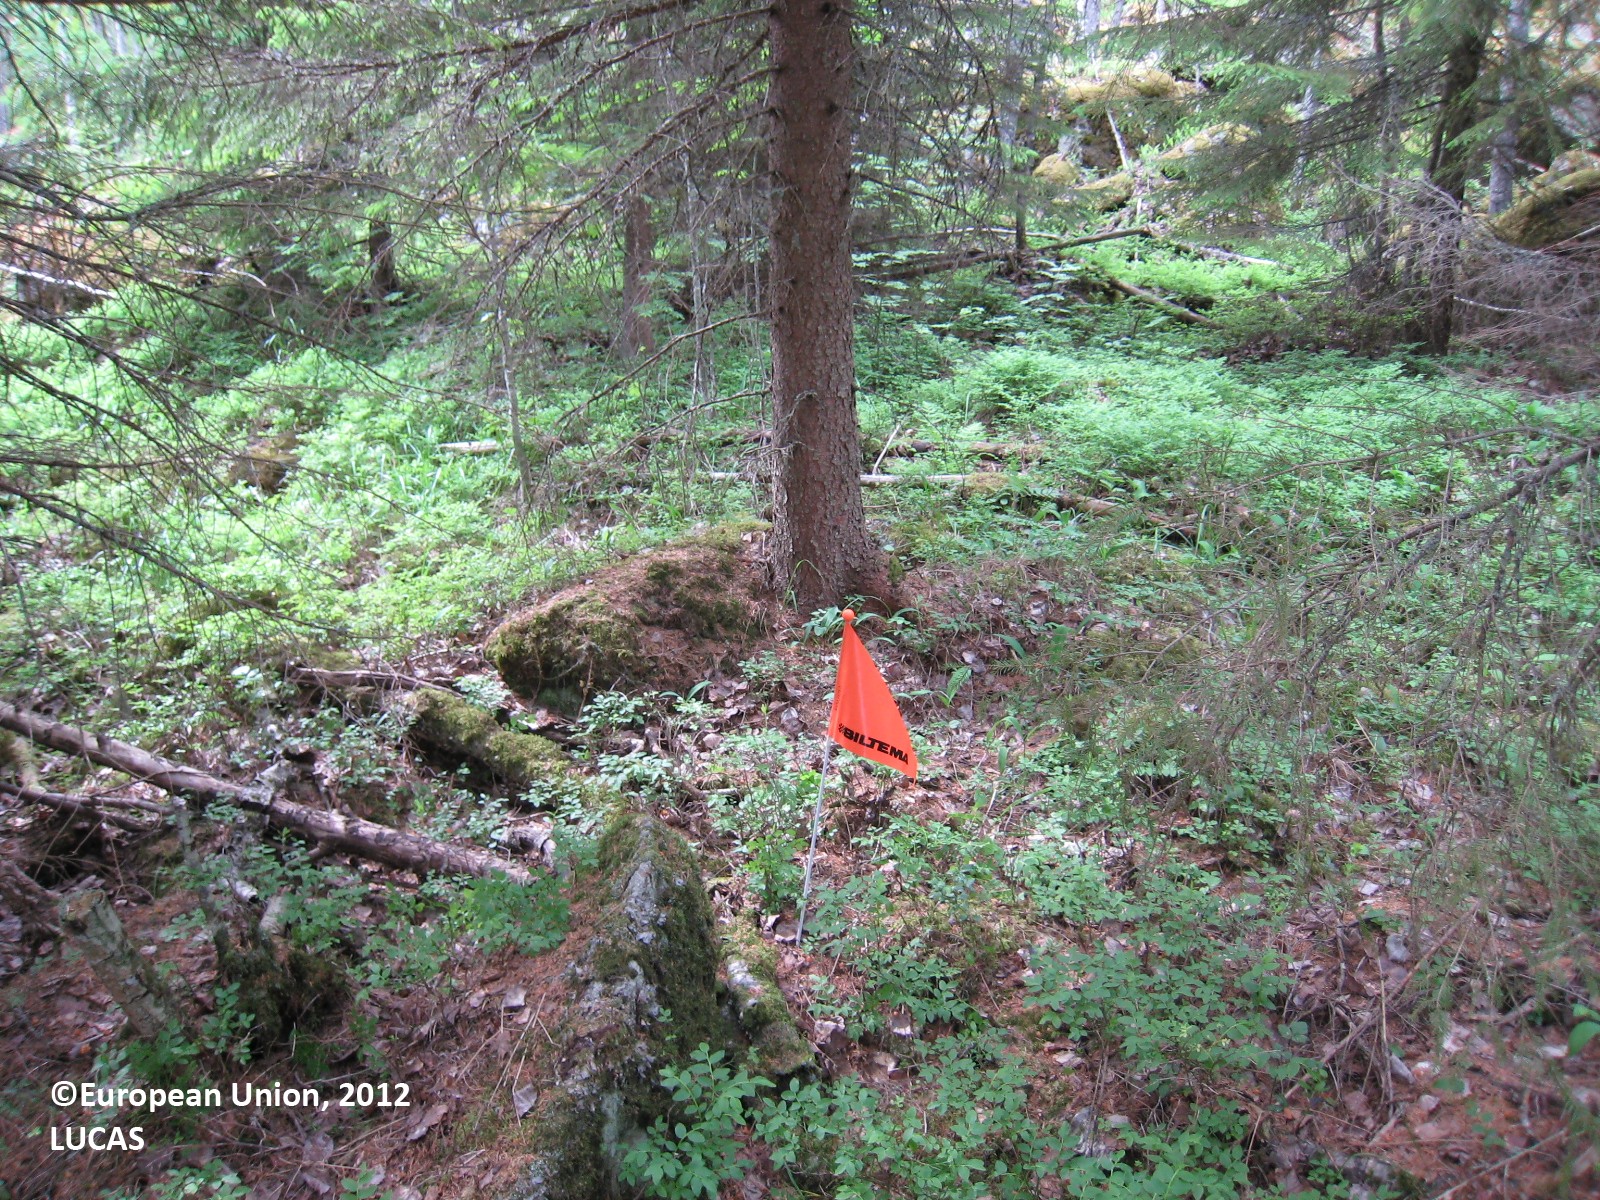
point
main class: Woodland
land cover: Spruce dominated mixed woodland
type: boreal forest
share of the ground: 50 - 75 %
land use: Forestry
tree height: > 5 m
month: June
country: FI
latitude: 61.6236
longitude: 25.9564
